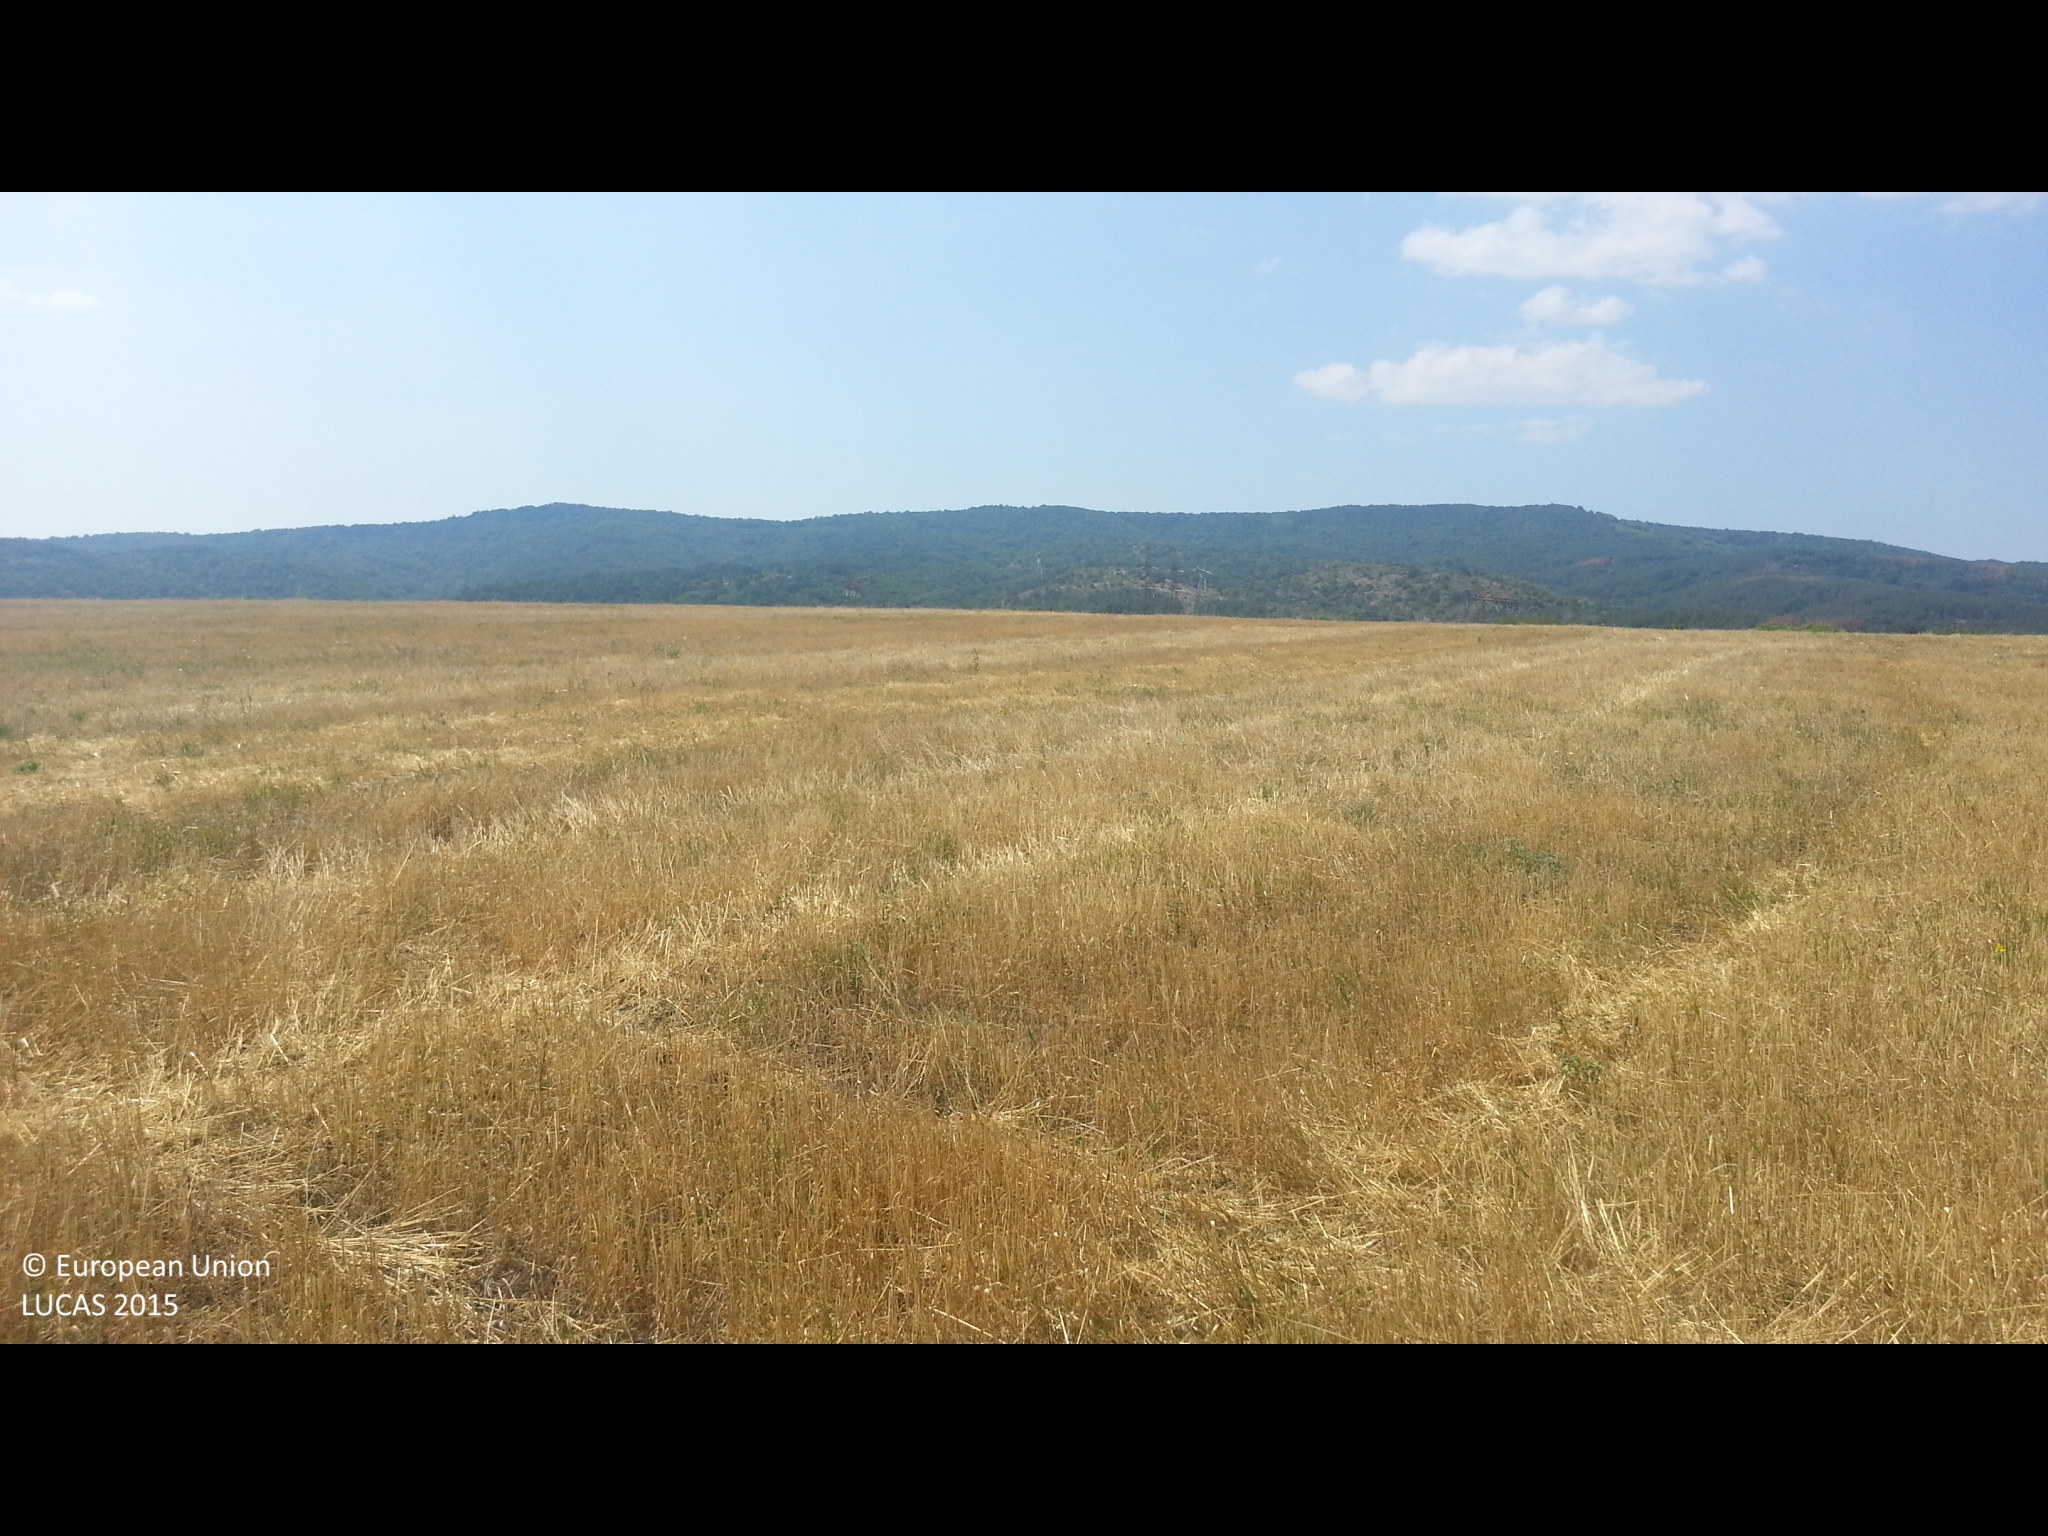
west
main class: Cropland
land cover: Common wheat
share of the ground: > 75 %
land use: Agriculture (excluding fallow land and kitchen gardens)
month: August
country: BG
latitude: 42.3889
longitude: 23.0613
